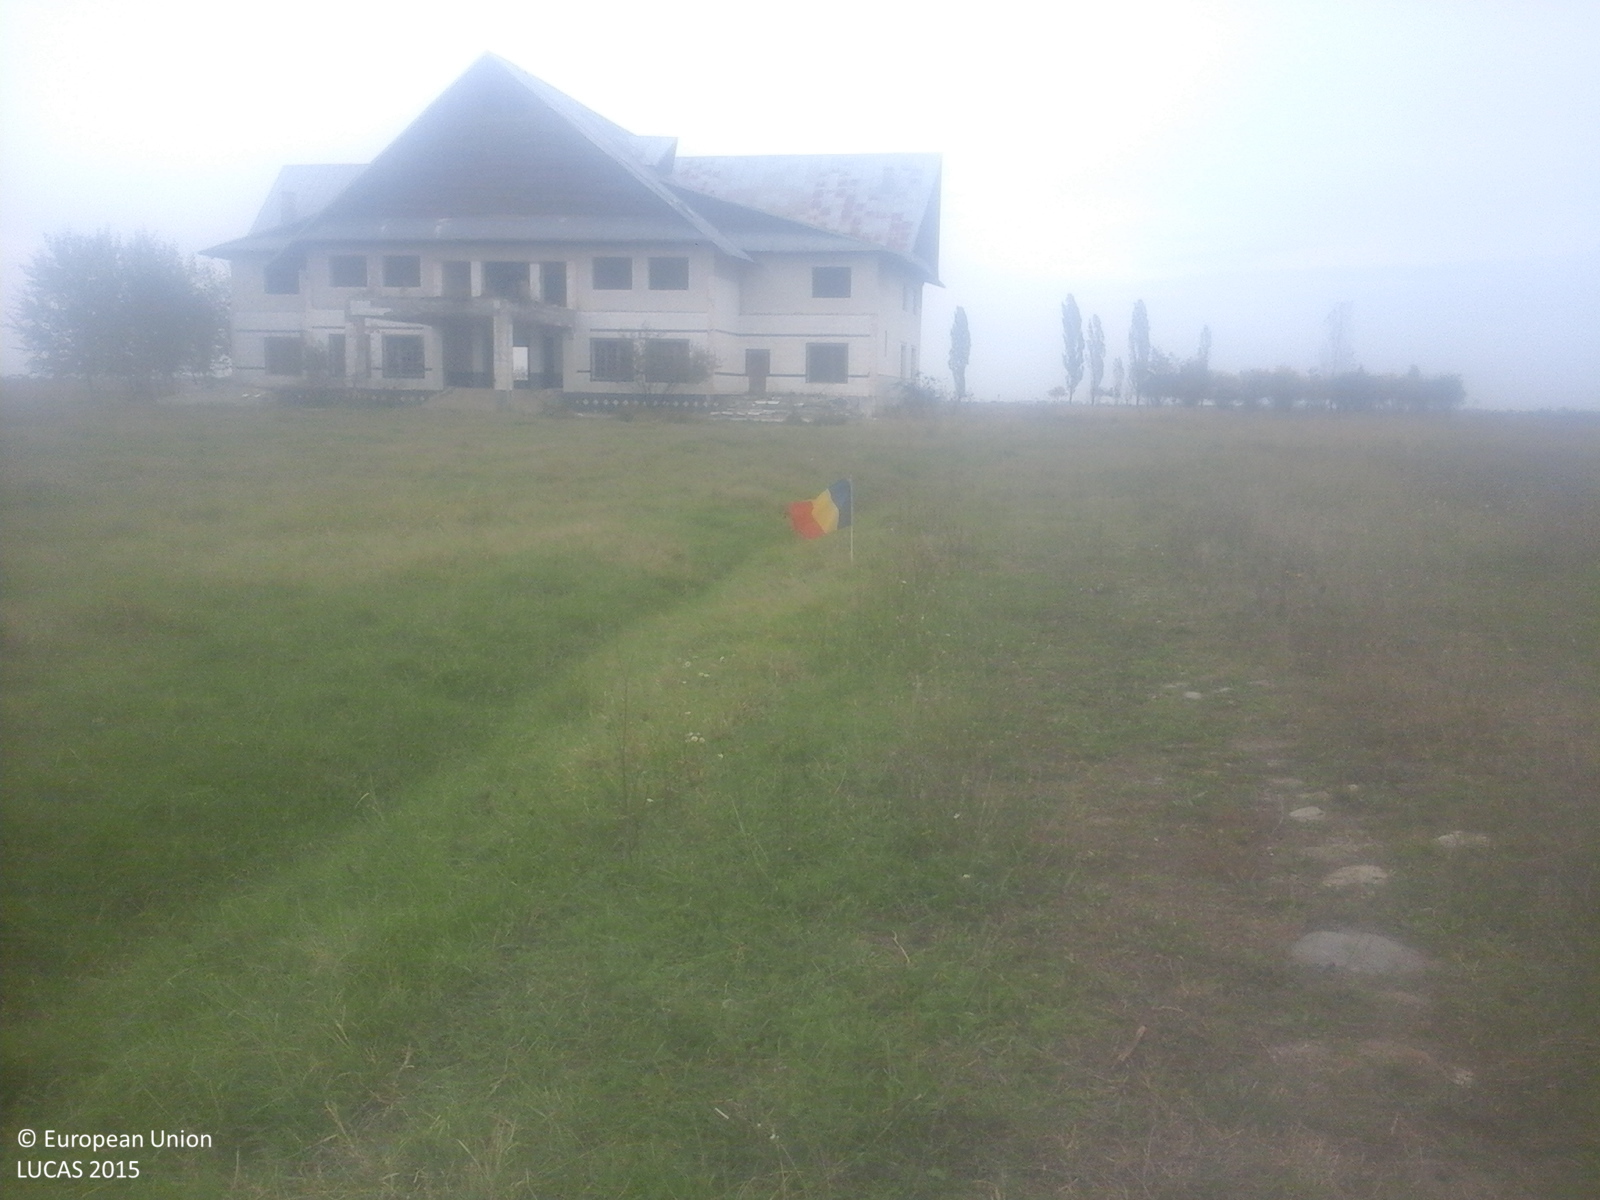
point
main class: Artificial land
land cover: Non built-up linear features
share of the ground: > 75 %
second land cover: Grassland without tree/shrub cover
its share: > 75 %
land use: Road transport
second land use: Residential
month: October
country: RO
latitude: 44.9716
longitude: 25.7616
